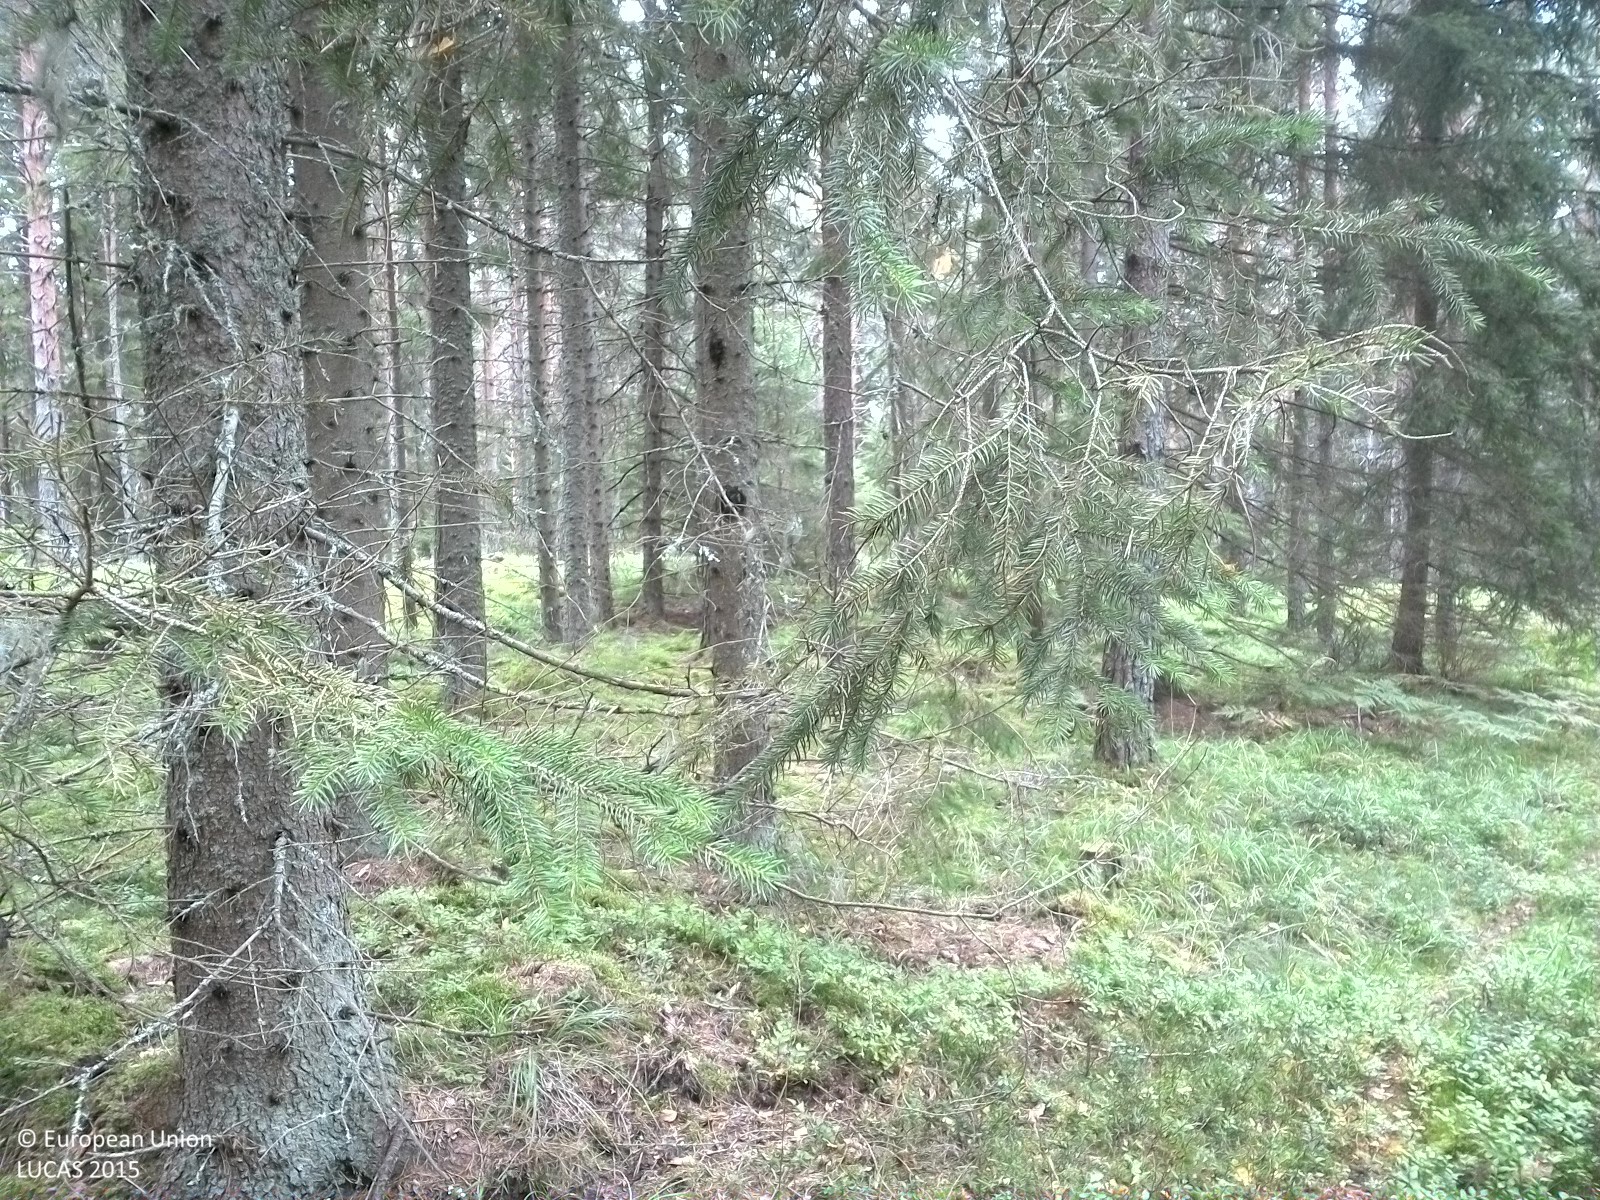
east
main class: Woodland
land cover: Other coniferous woodland
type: boreal forest
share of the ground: 25 - 50 %
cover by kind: coniferous forest trees 45 %, herbaceous plants 30 %, lichens and mosses 20 %, shrubs 5 %
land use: Forestry
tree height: > 5 m
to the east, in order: Other coniferous woodland; Pine dominated coniferous woodland; Tracks; Other coniferous woodland; Other mixed woodland
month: August
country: SE
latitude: 58.8758
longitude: 15.6651
